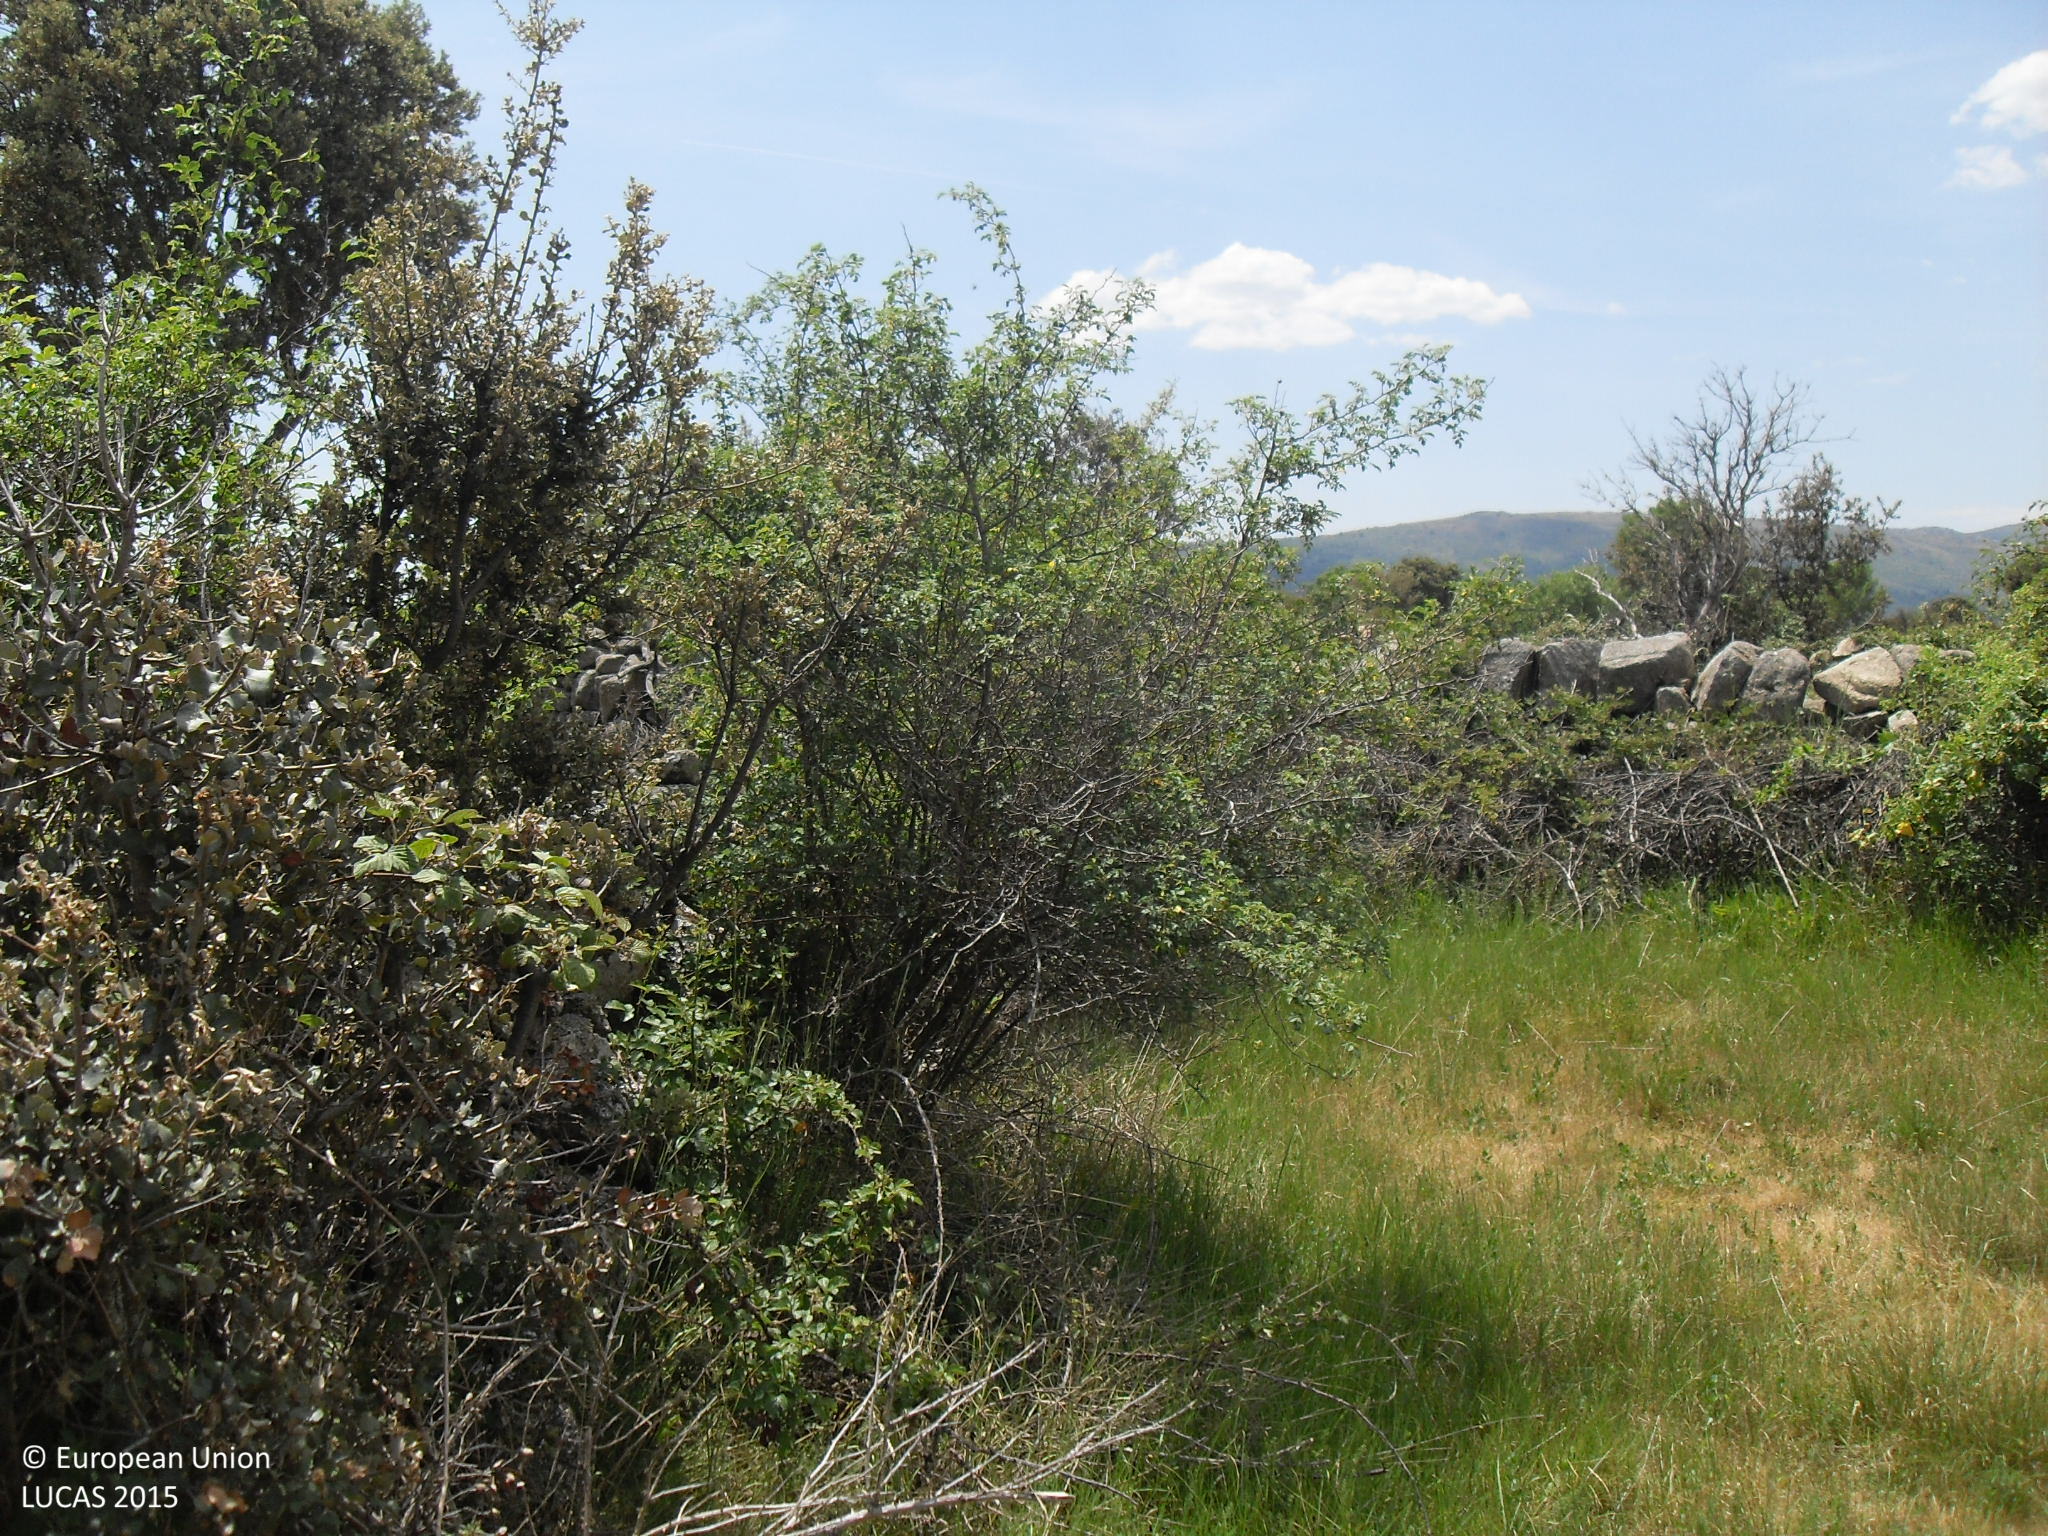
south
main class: Grassland
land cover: Grassland without tree/shrub cover
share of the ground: > 75 %
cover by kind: herbaceous plants 100 %
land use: Agriculture (excluding fallow land and kitchen gardens)
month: June
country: ES
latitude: 40.4351
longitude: -5.5454
